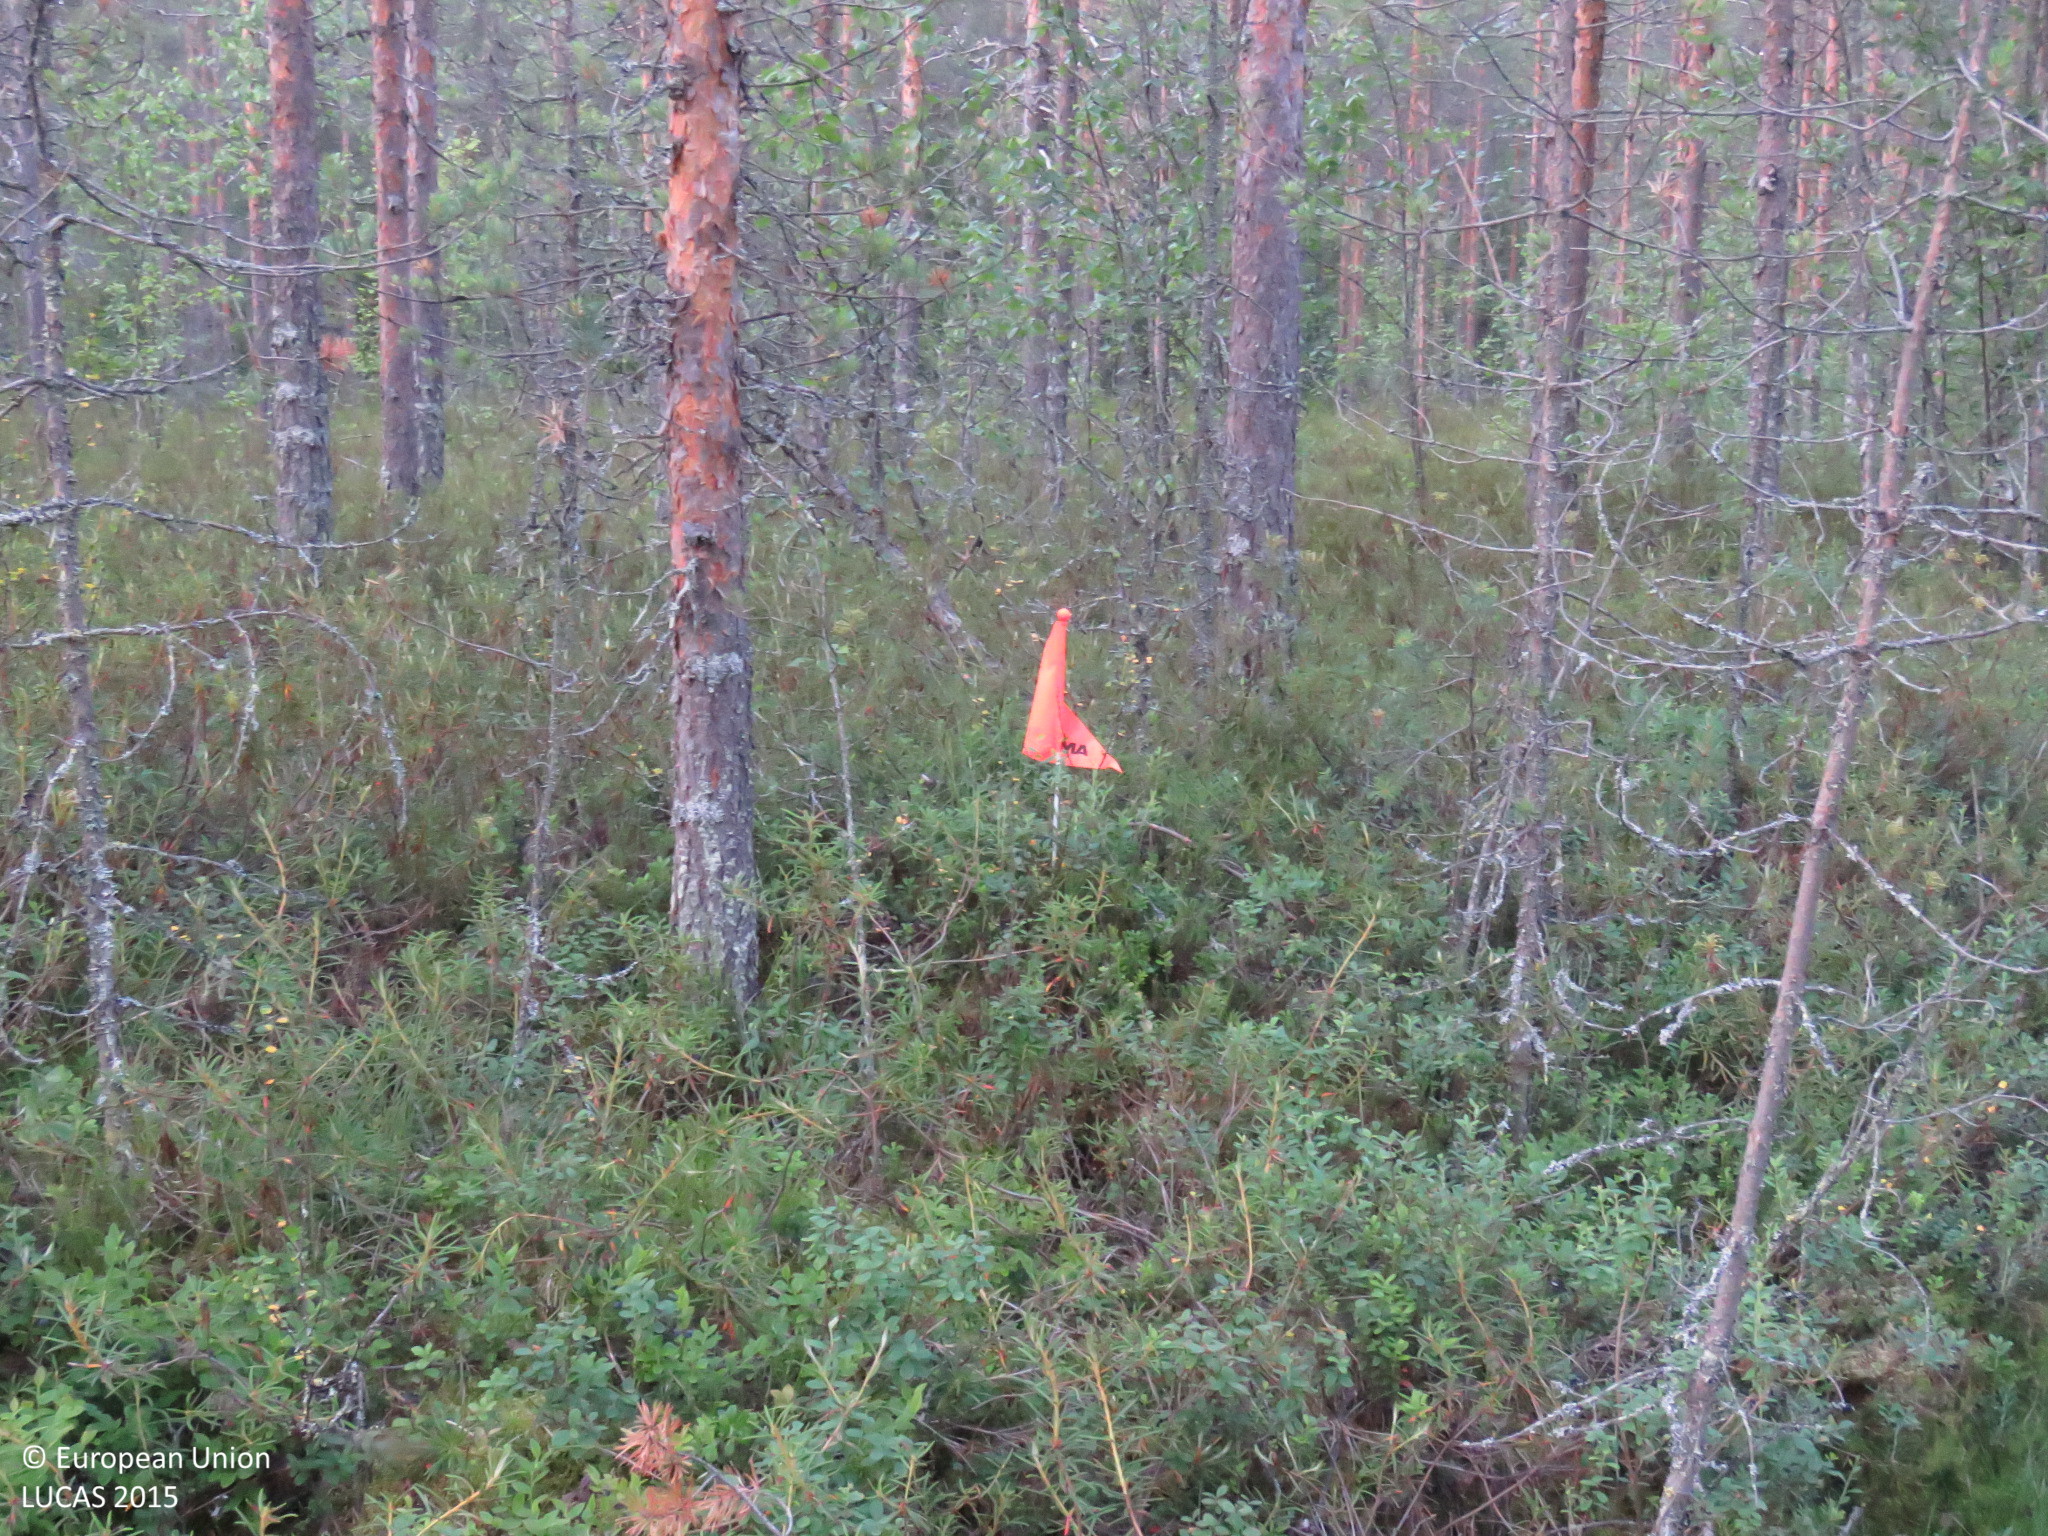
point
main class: Woodland
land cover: Pine dominated coniferous woodland
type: boreal forest
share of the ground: > 75 %
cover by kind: coniferous forest trees 80 %, broadleaved forest trees 10 %, shrubs 10 %
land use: Forestry
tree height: > 5 m
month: July
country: FI
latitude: 64.7684
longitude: 26.3165
